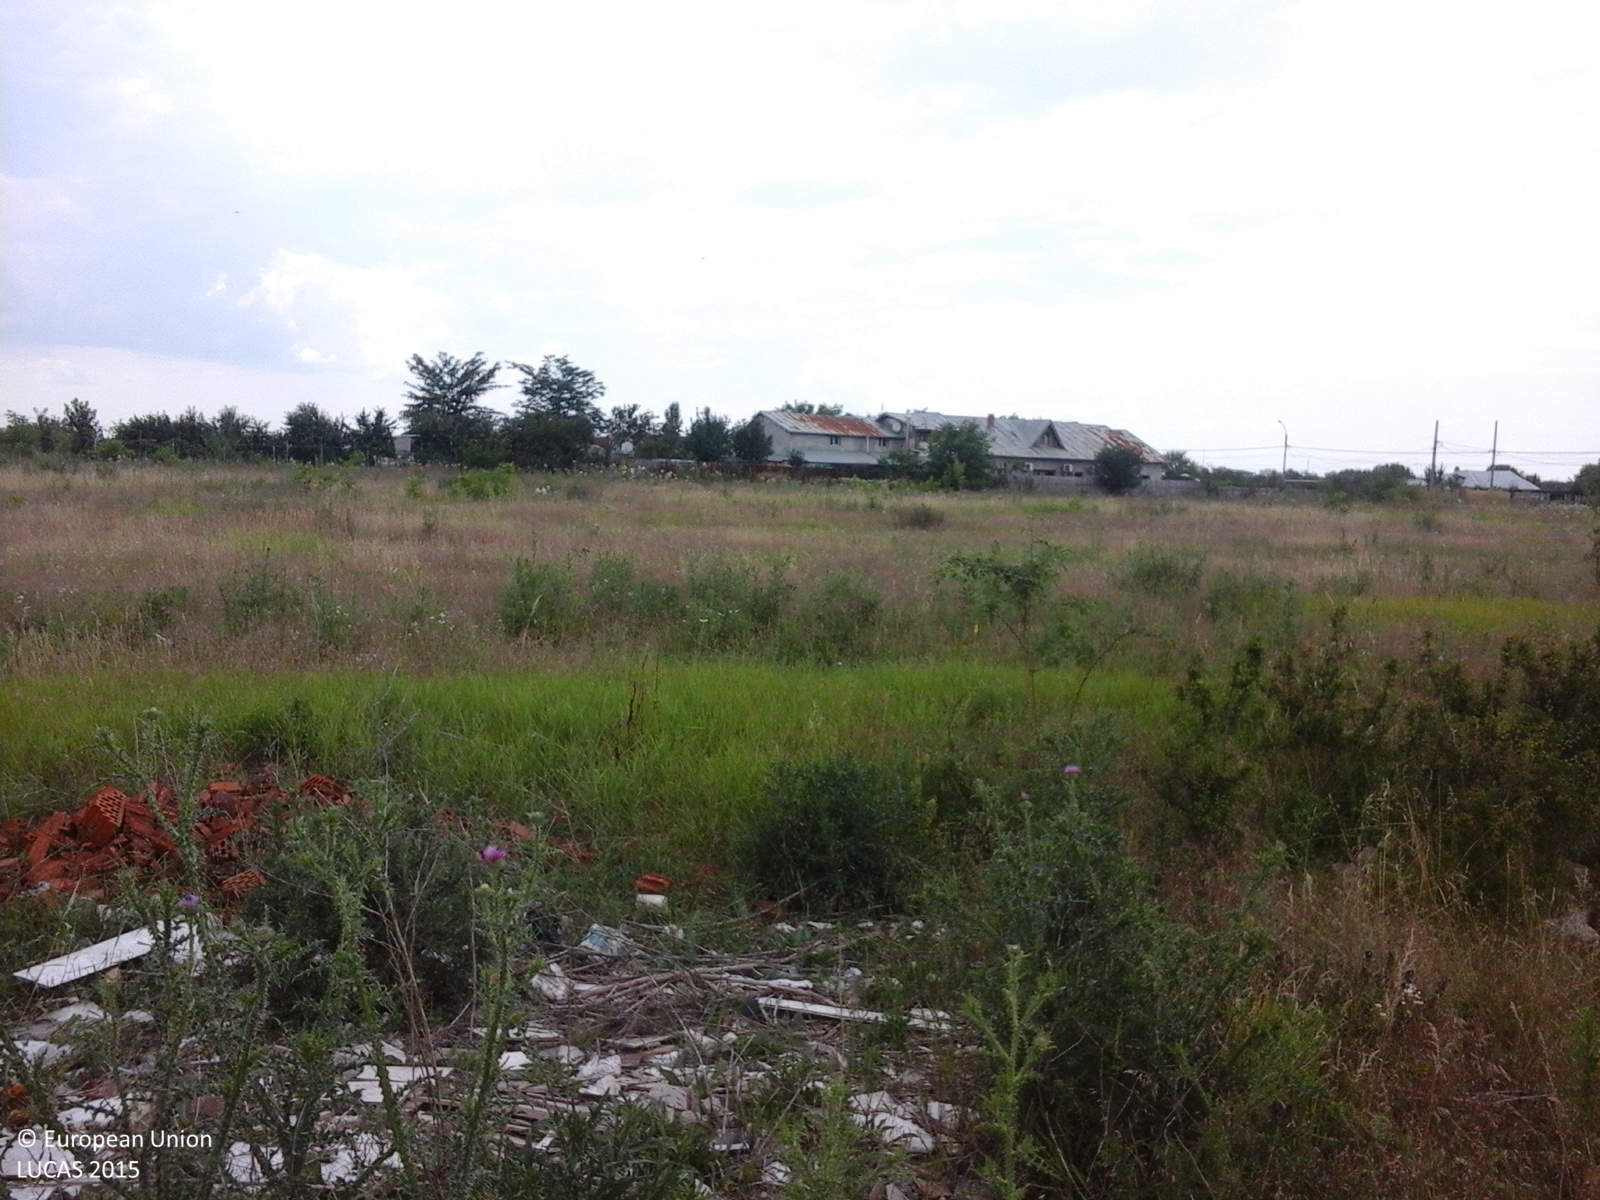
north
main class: Grassland
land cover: Grassland with sparse tree/shrub cover
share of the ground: > 75 %
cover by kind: herbaceous plants 85 %, shrubs 10 %, broadleaved forest trees 5 %
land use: Agriculture (excluding fallow land and kitchen gardens)
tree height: < 5 m
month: June
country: RO
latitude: 44.3720
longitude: 26.0795
